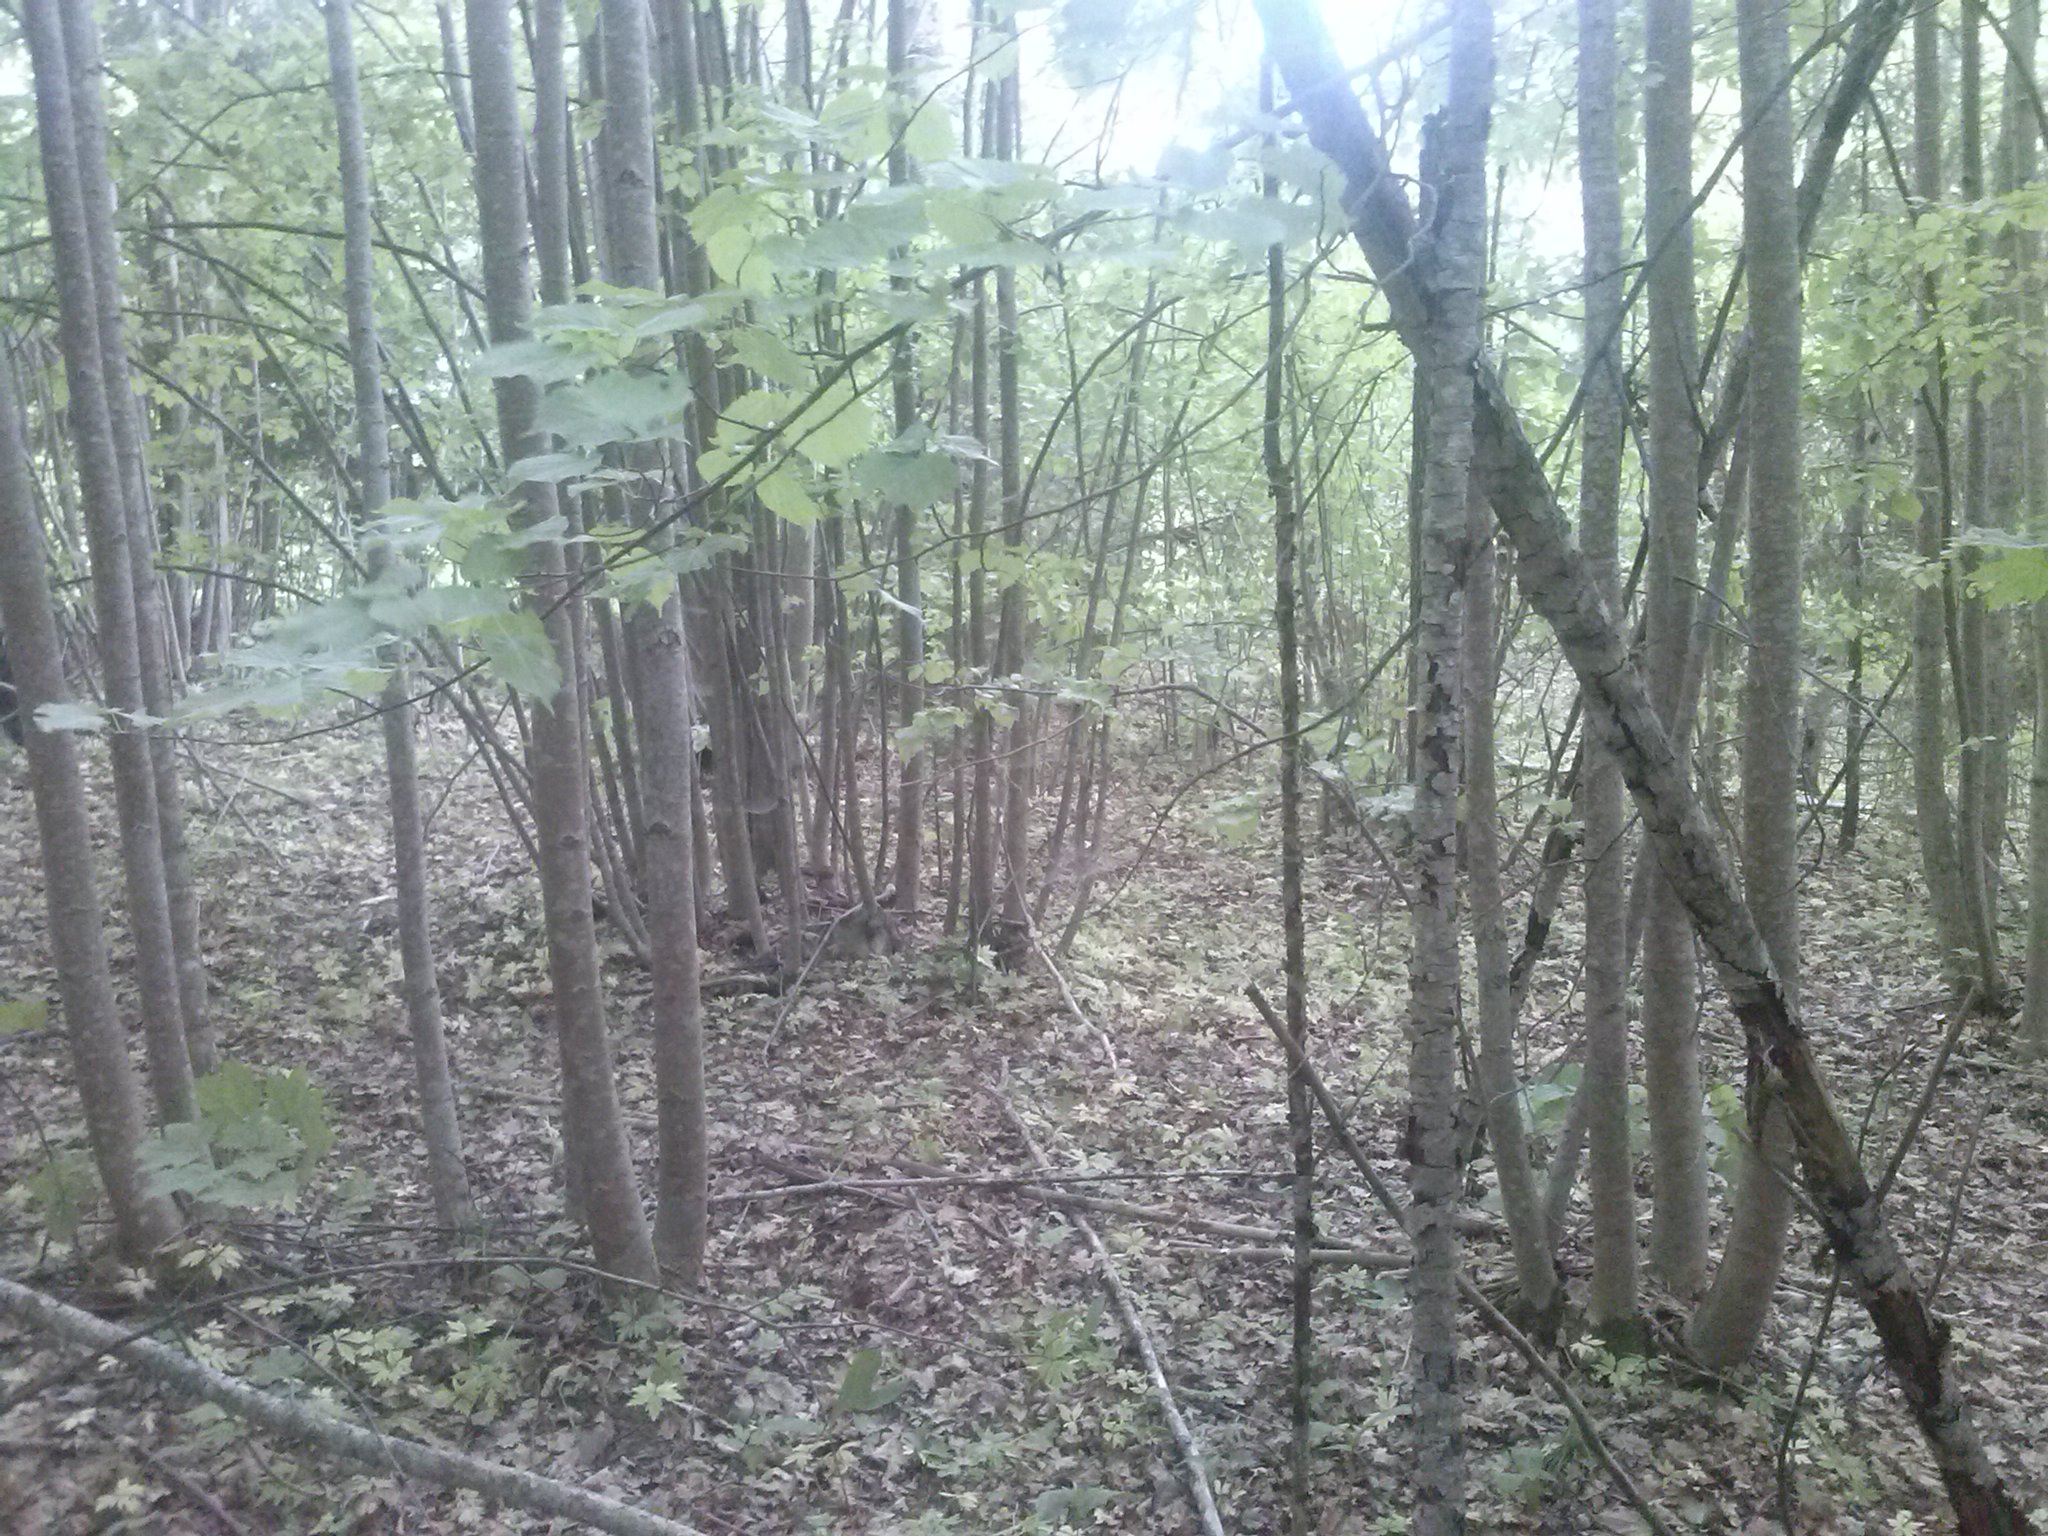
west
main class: Woodland
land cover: Broadleaved woodland
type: non-riverine alder, birch or aspen forest
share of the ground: > 75 %
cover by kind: broadleaved forest trees 80 %, shrubs 5 %, herbaceous plants 5 %, unconsolidated bare surface 5 %
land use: Forestry
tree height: > 5 m
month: June
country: LV
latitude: 56.2924
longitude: 27.5508
